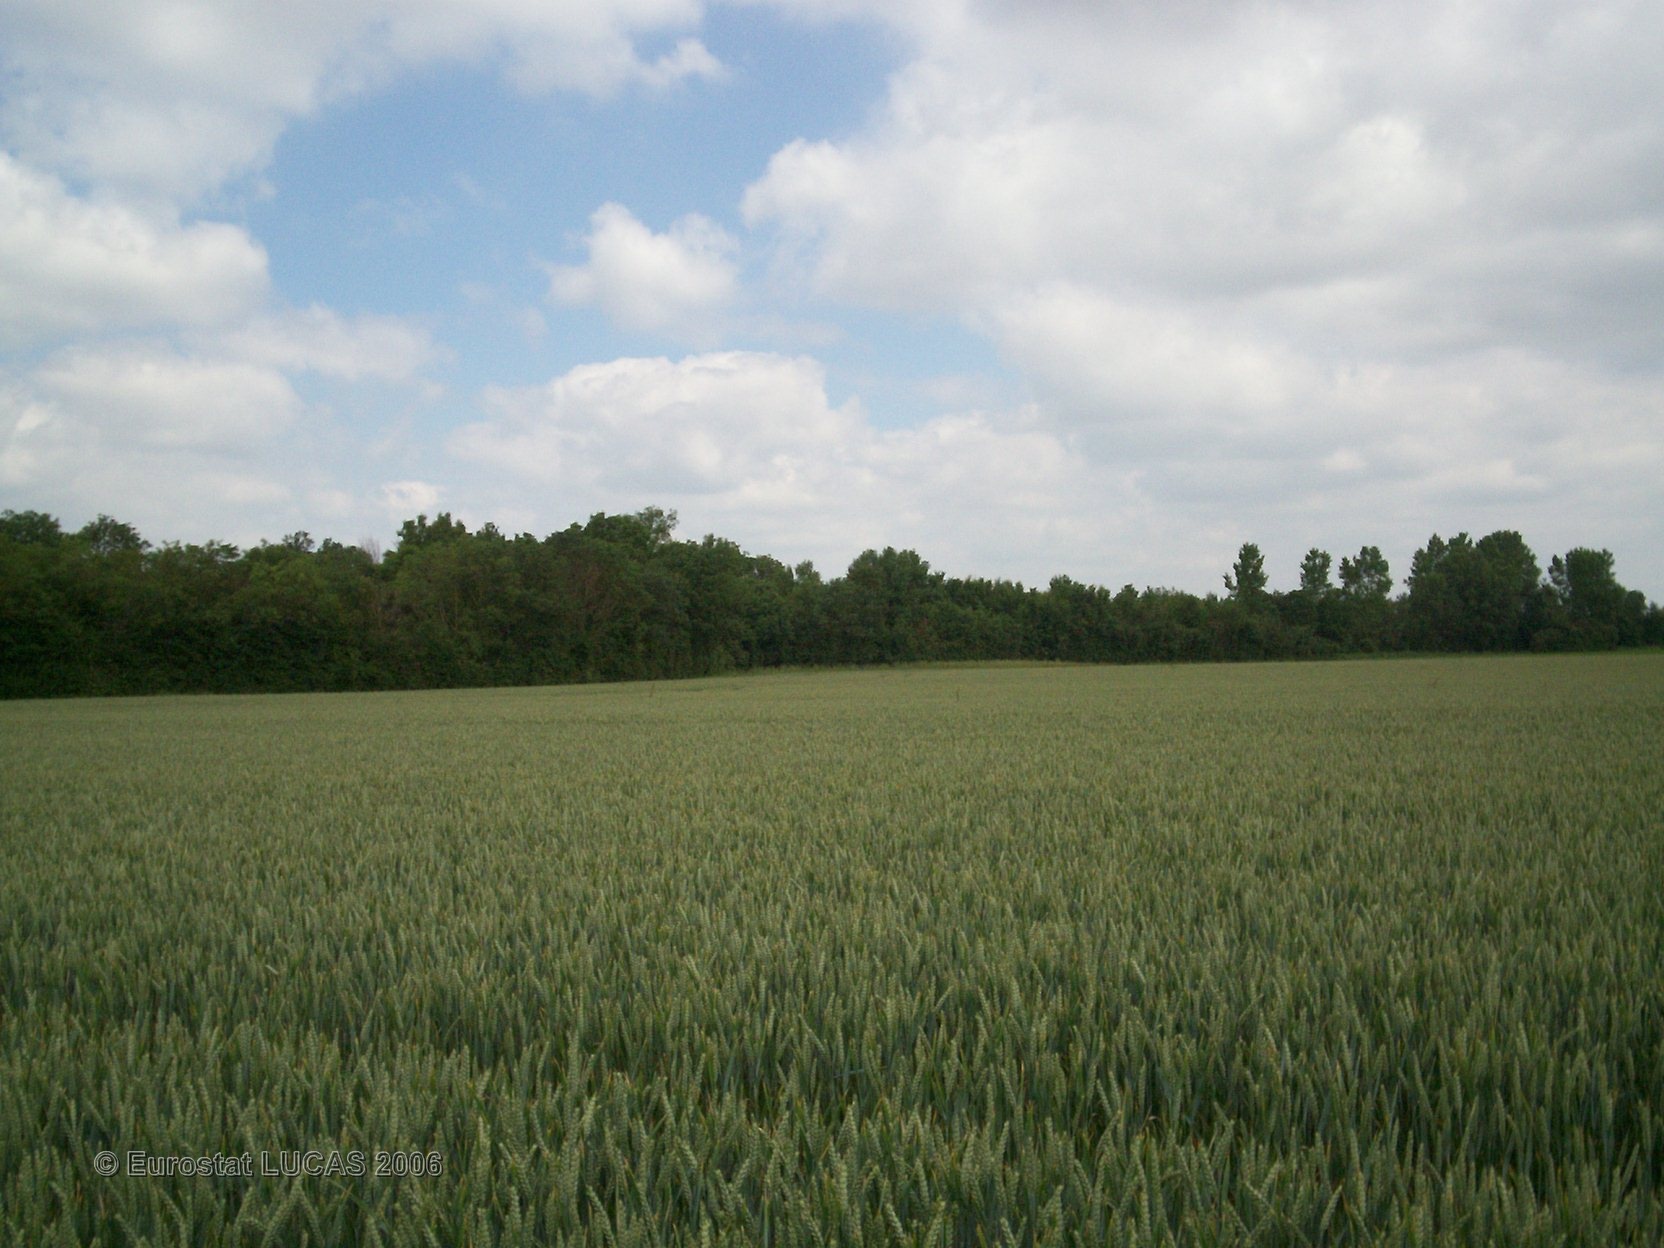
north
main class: Cropland
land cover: Common wheat
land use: Agriculture (excluding fallow land and kitchen gardens)
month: June
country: FR
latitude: 46.1539
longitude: -0.9188
